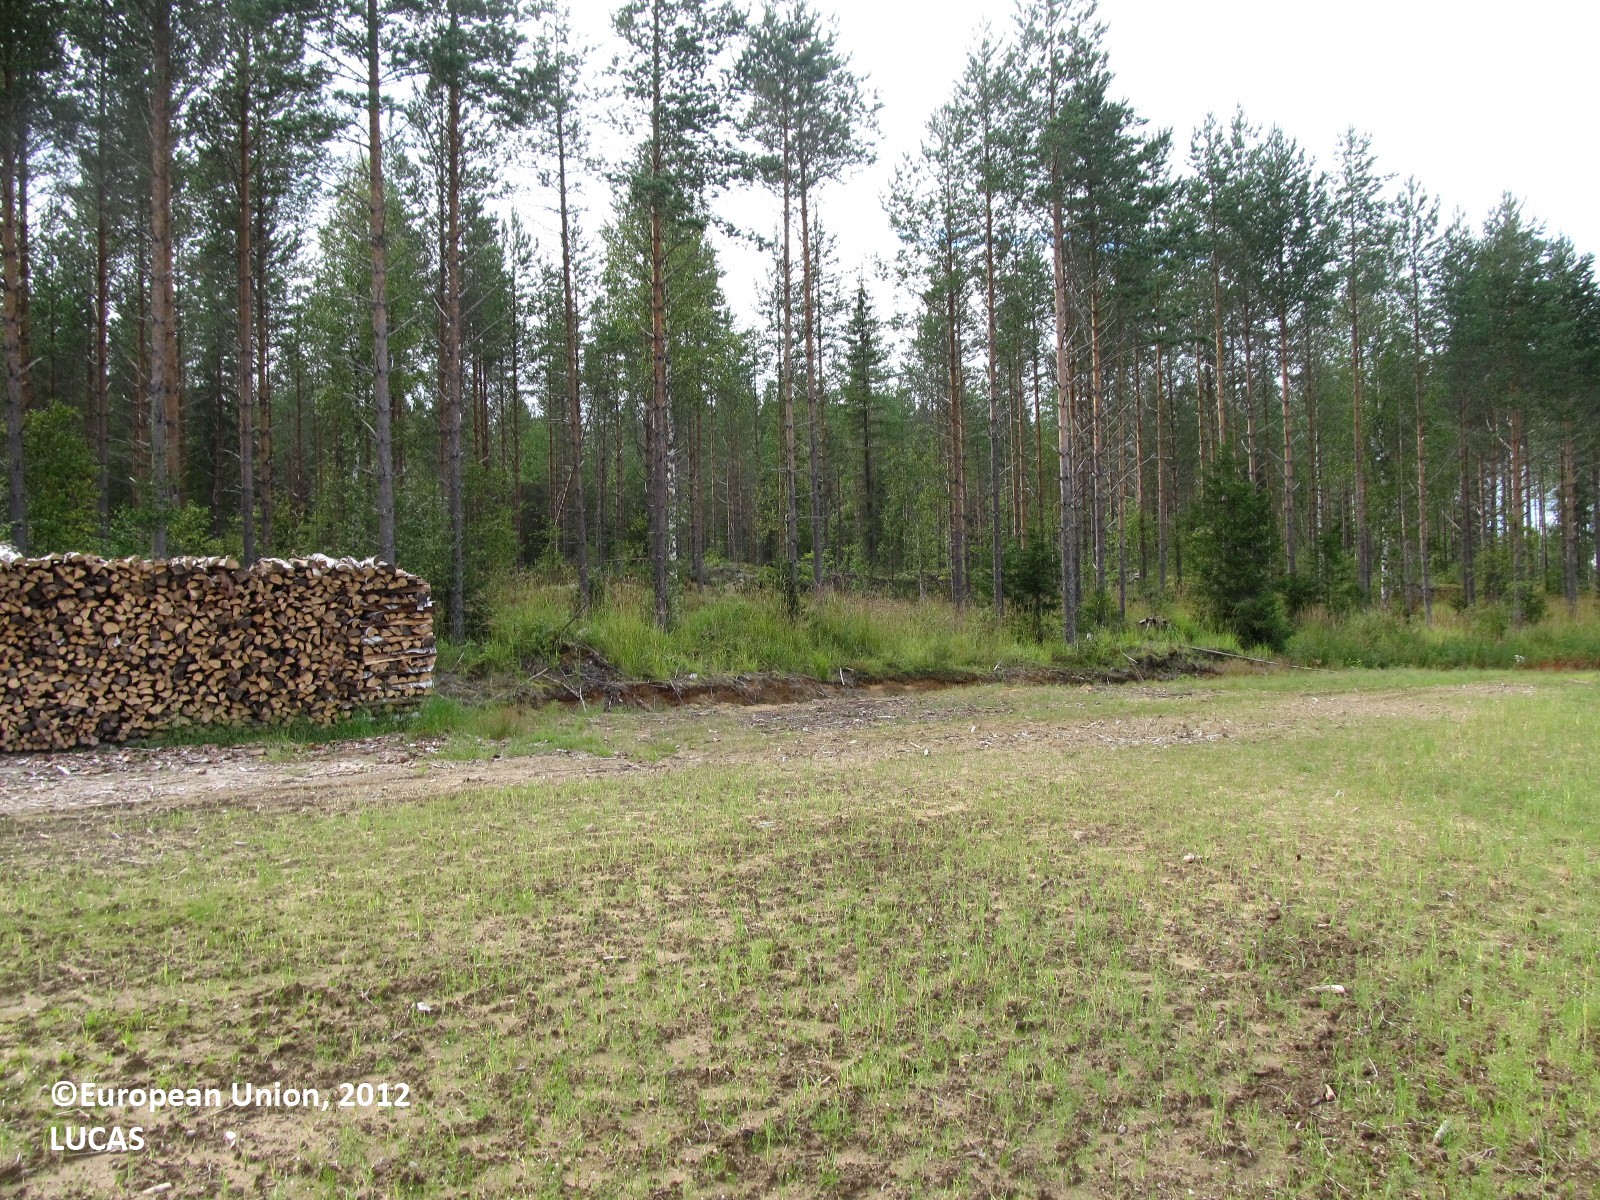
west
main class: Cropland
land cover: Oats
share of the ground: > 75 %
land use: Agriculture (excluding fallow land and kitchen gardens)
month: August
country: FI
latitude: 62.3346
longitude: 28.5652
